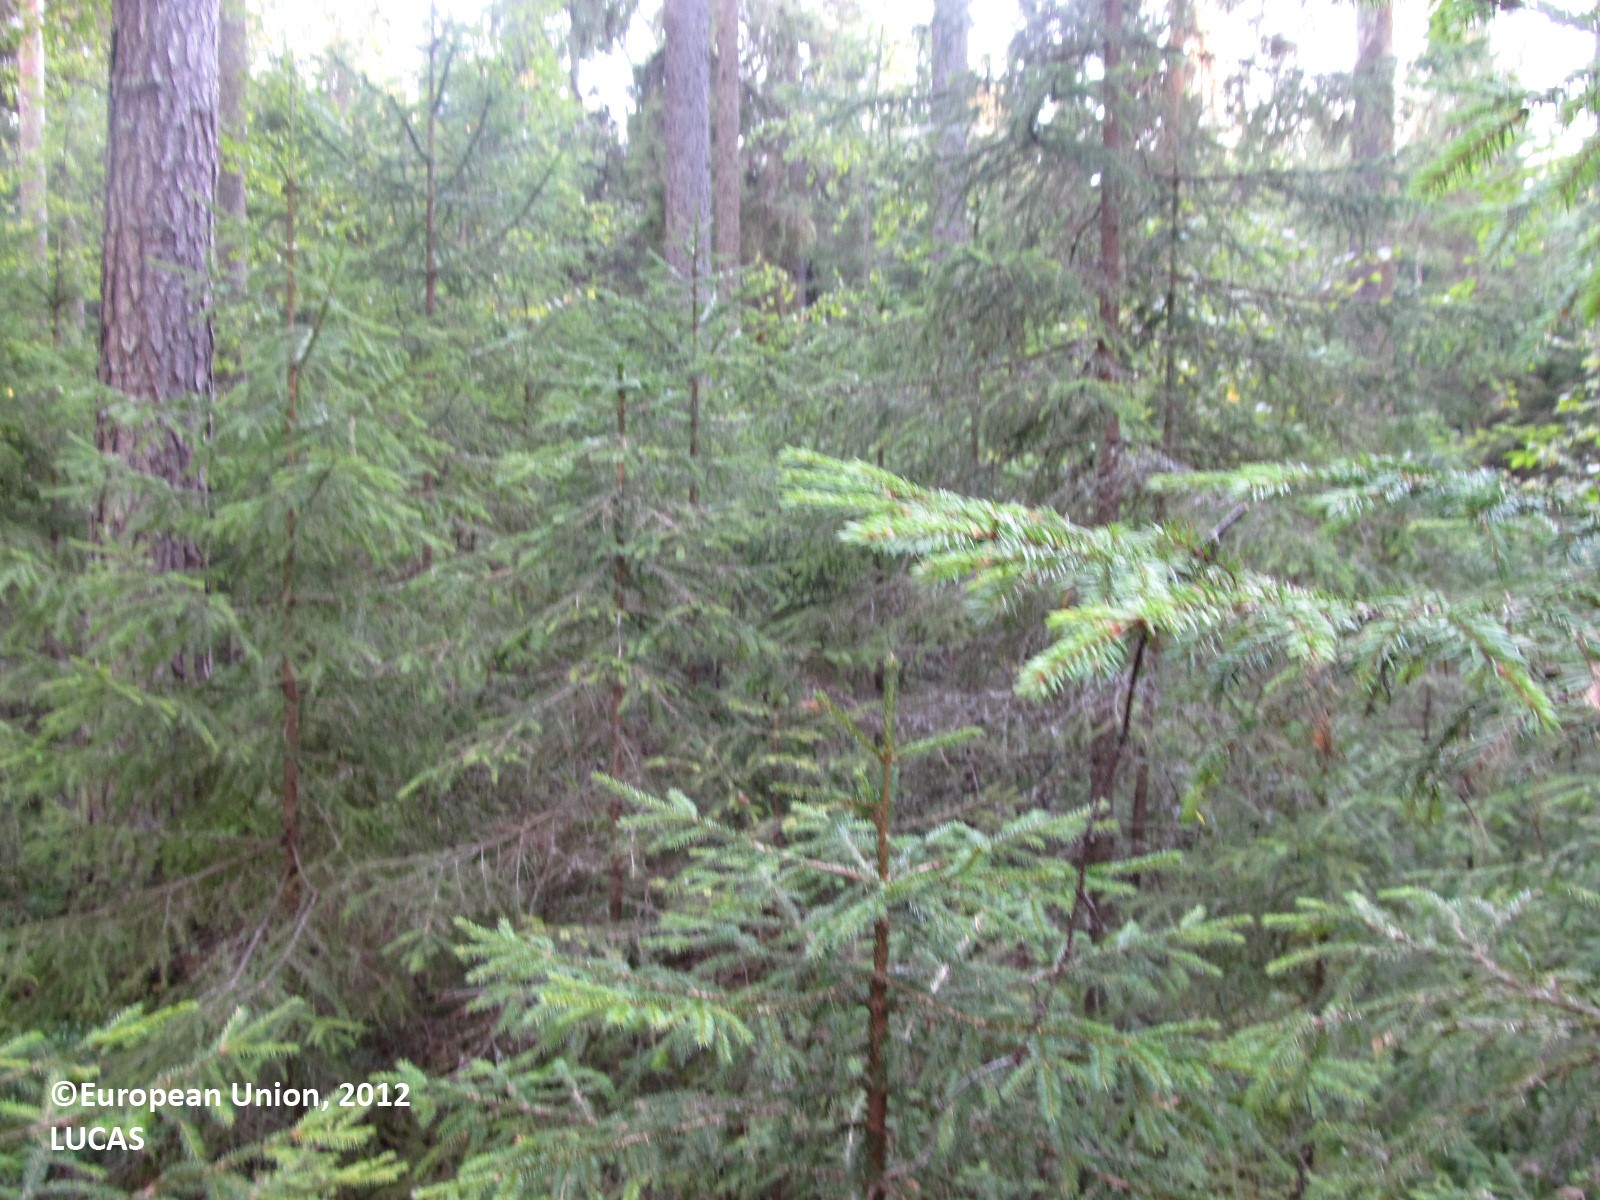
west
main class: Woodland
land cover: Other coniferous woodland
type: boreal forest
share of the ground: 50 - 75 %
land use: Forestry
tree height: > 5 m
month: August
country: FI
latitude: 62.1057
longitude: 27.7098
